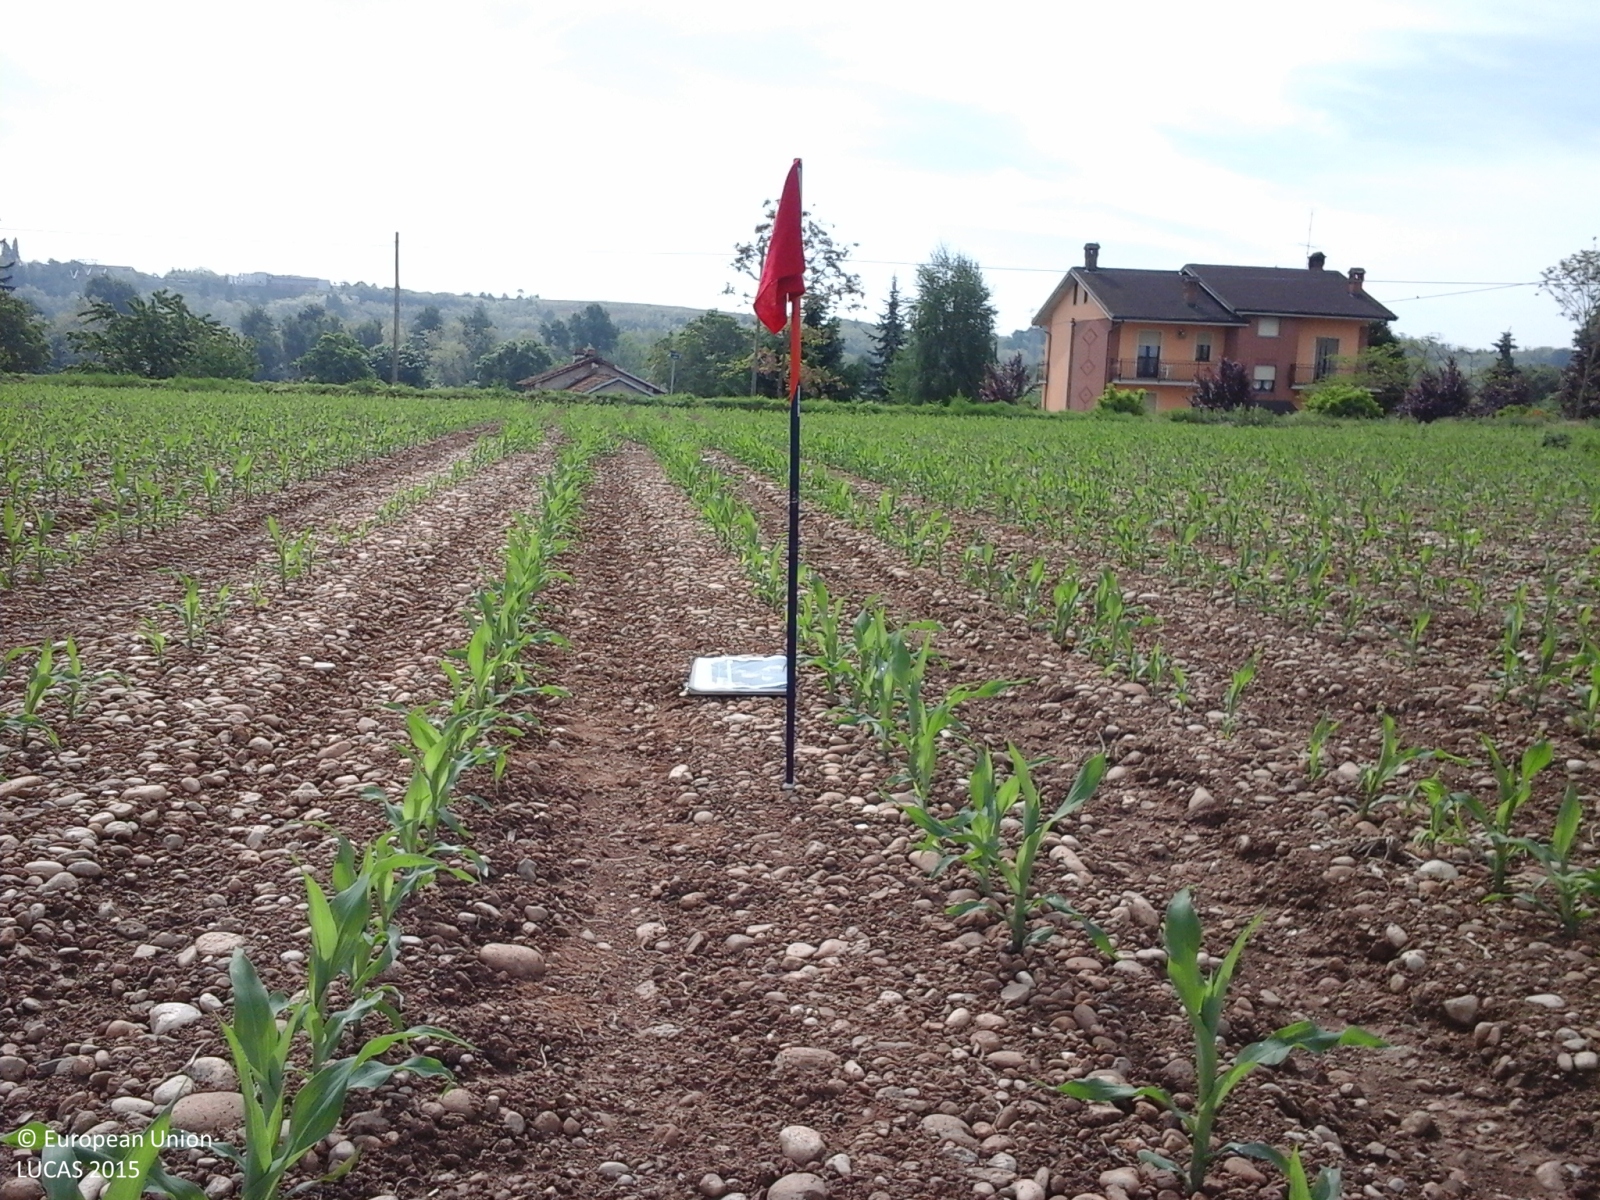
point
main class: Cropland
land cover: Maize
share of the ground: 25 - 50 %
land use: Agriculture (excluding fallow land and kitchen gardens)
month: May
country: IT
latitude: 44.5427
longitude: 7.7517
